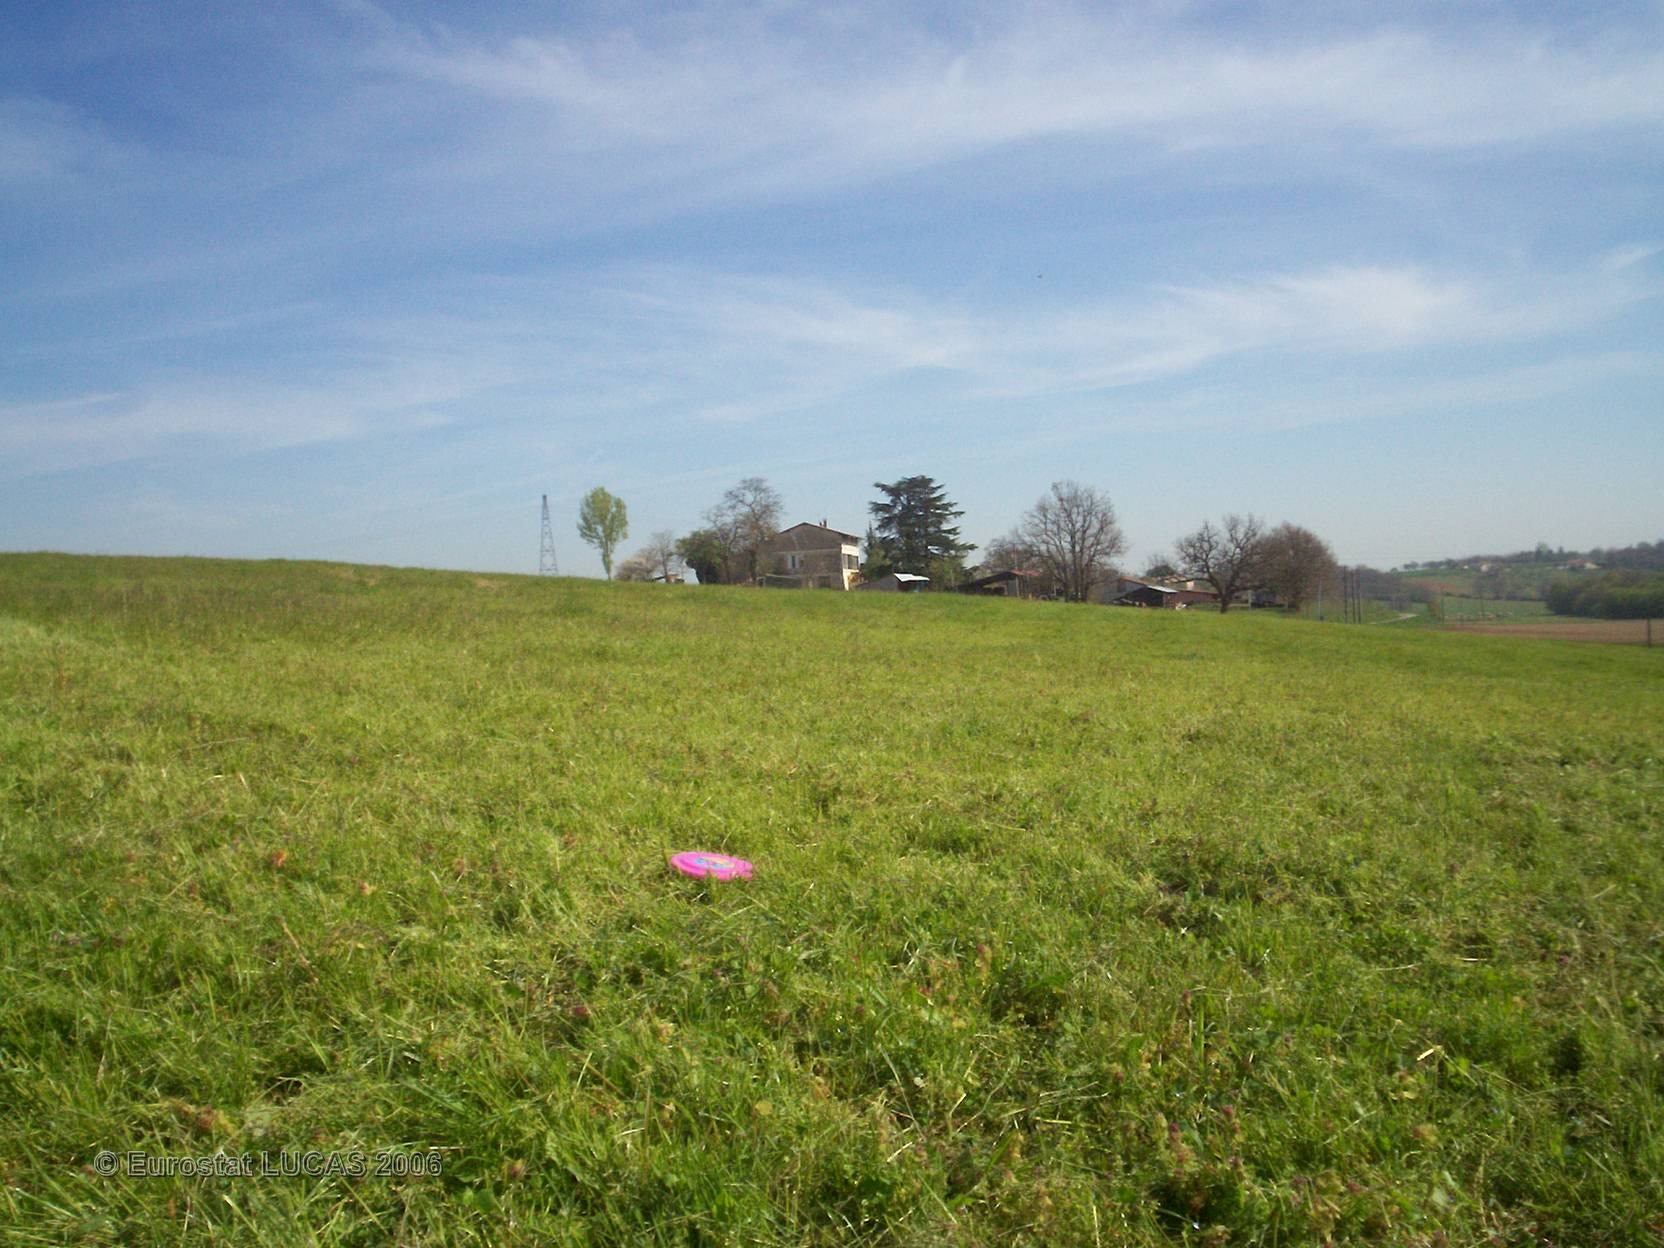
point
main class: Grassland
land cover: Grassland without tree/shrub cover
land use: Agriculture (excluding fallow land and kitchen gardens)
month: April
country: FR
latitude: 44.0115
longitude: 0.9798
